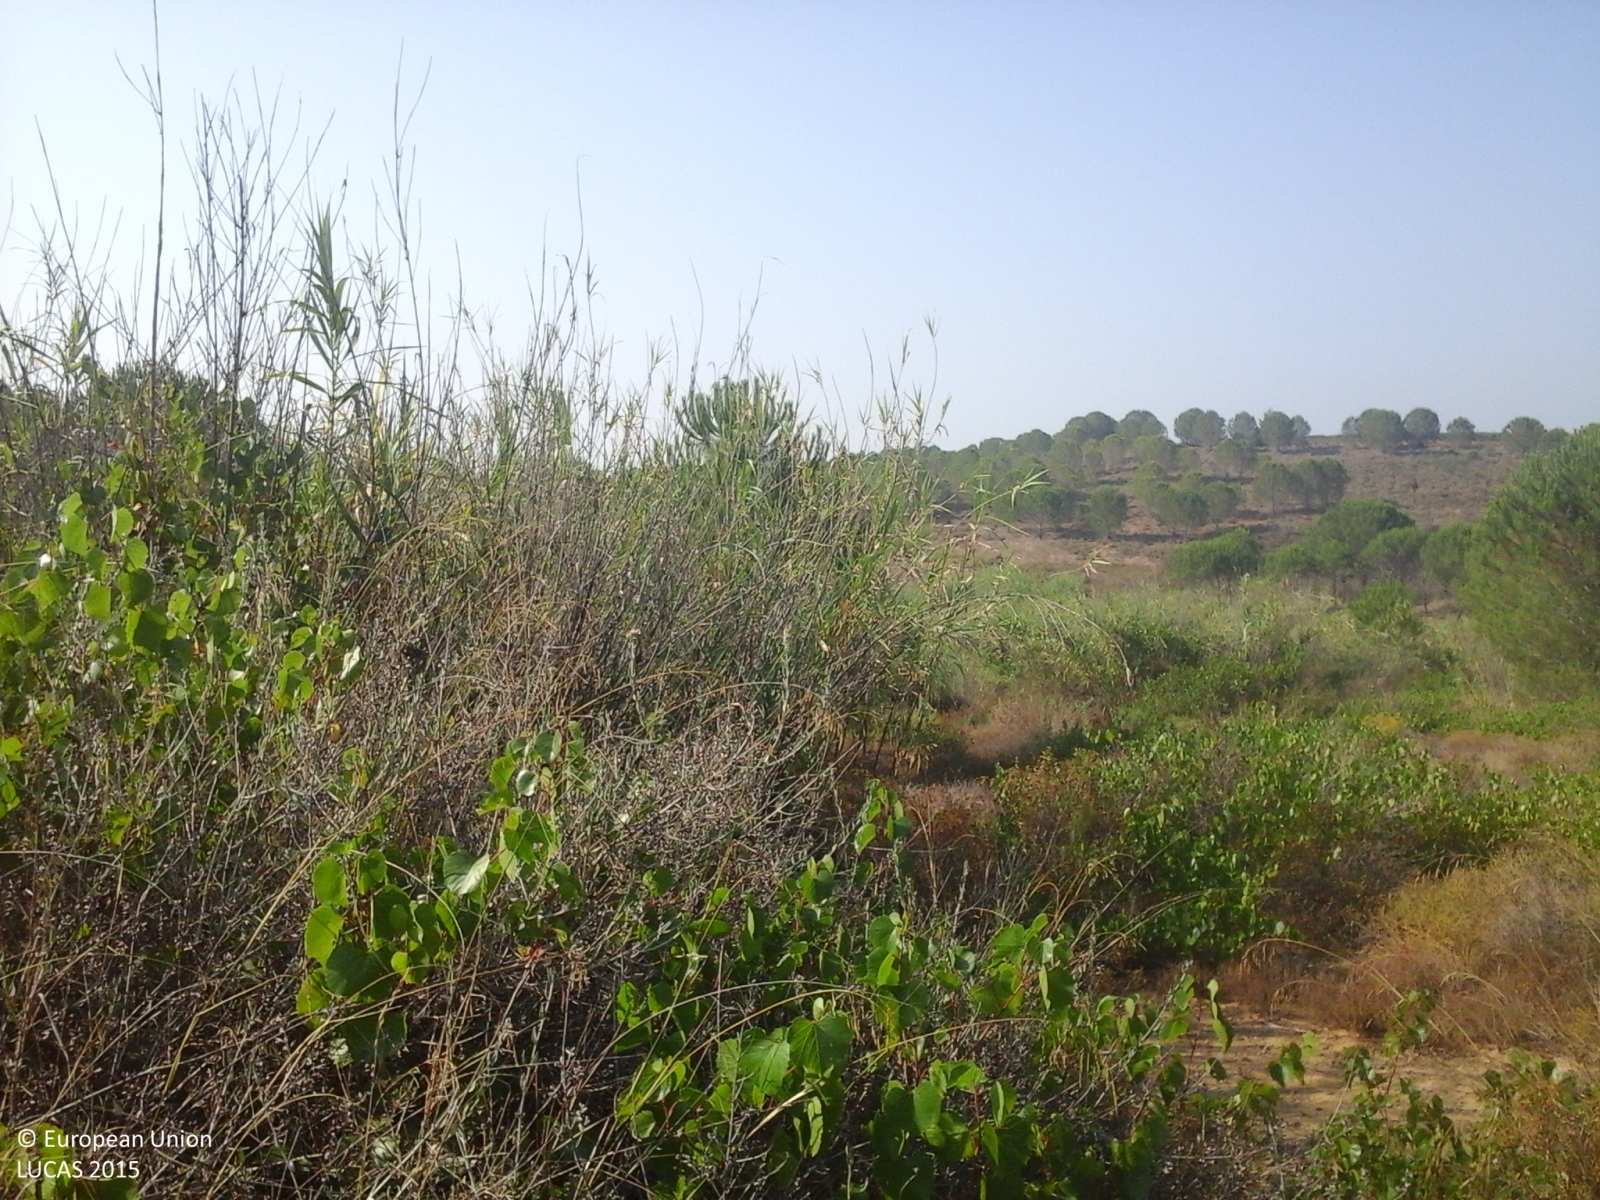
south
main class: Shrubland
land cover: Shrubland with sparse tree cover
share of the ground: > 75 %
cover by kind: shrubs 70 %, herbaceous plants 25 %, coniferous forest trees 5 %
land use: Semi-natural and natural areas not in use
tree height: < 5 m
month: July
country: IT
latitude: 37.0997
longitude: 14.4099
